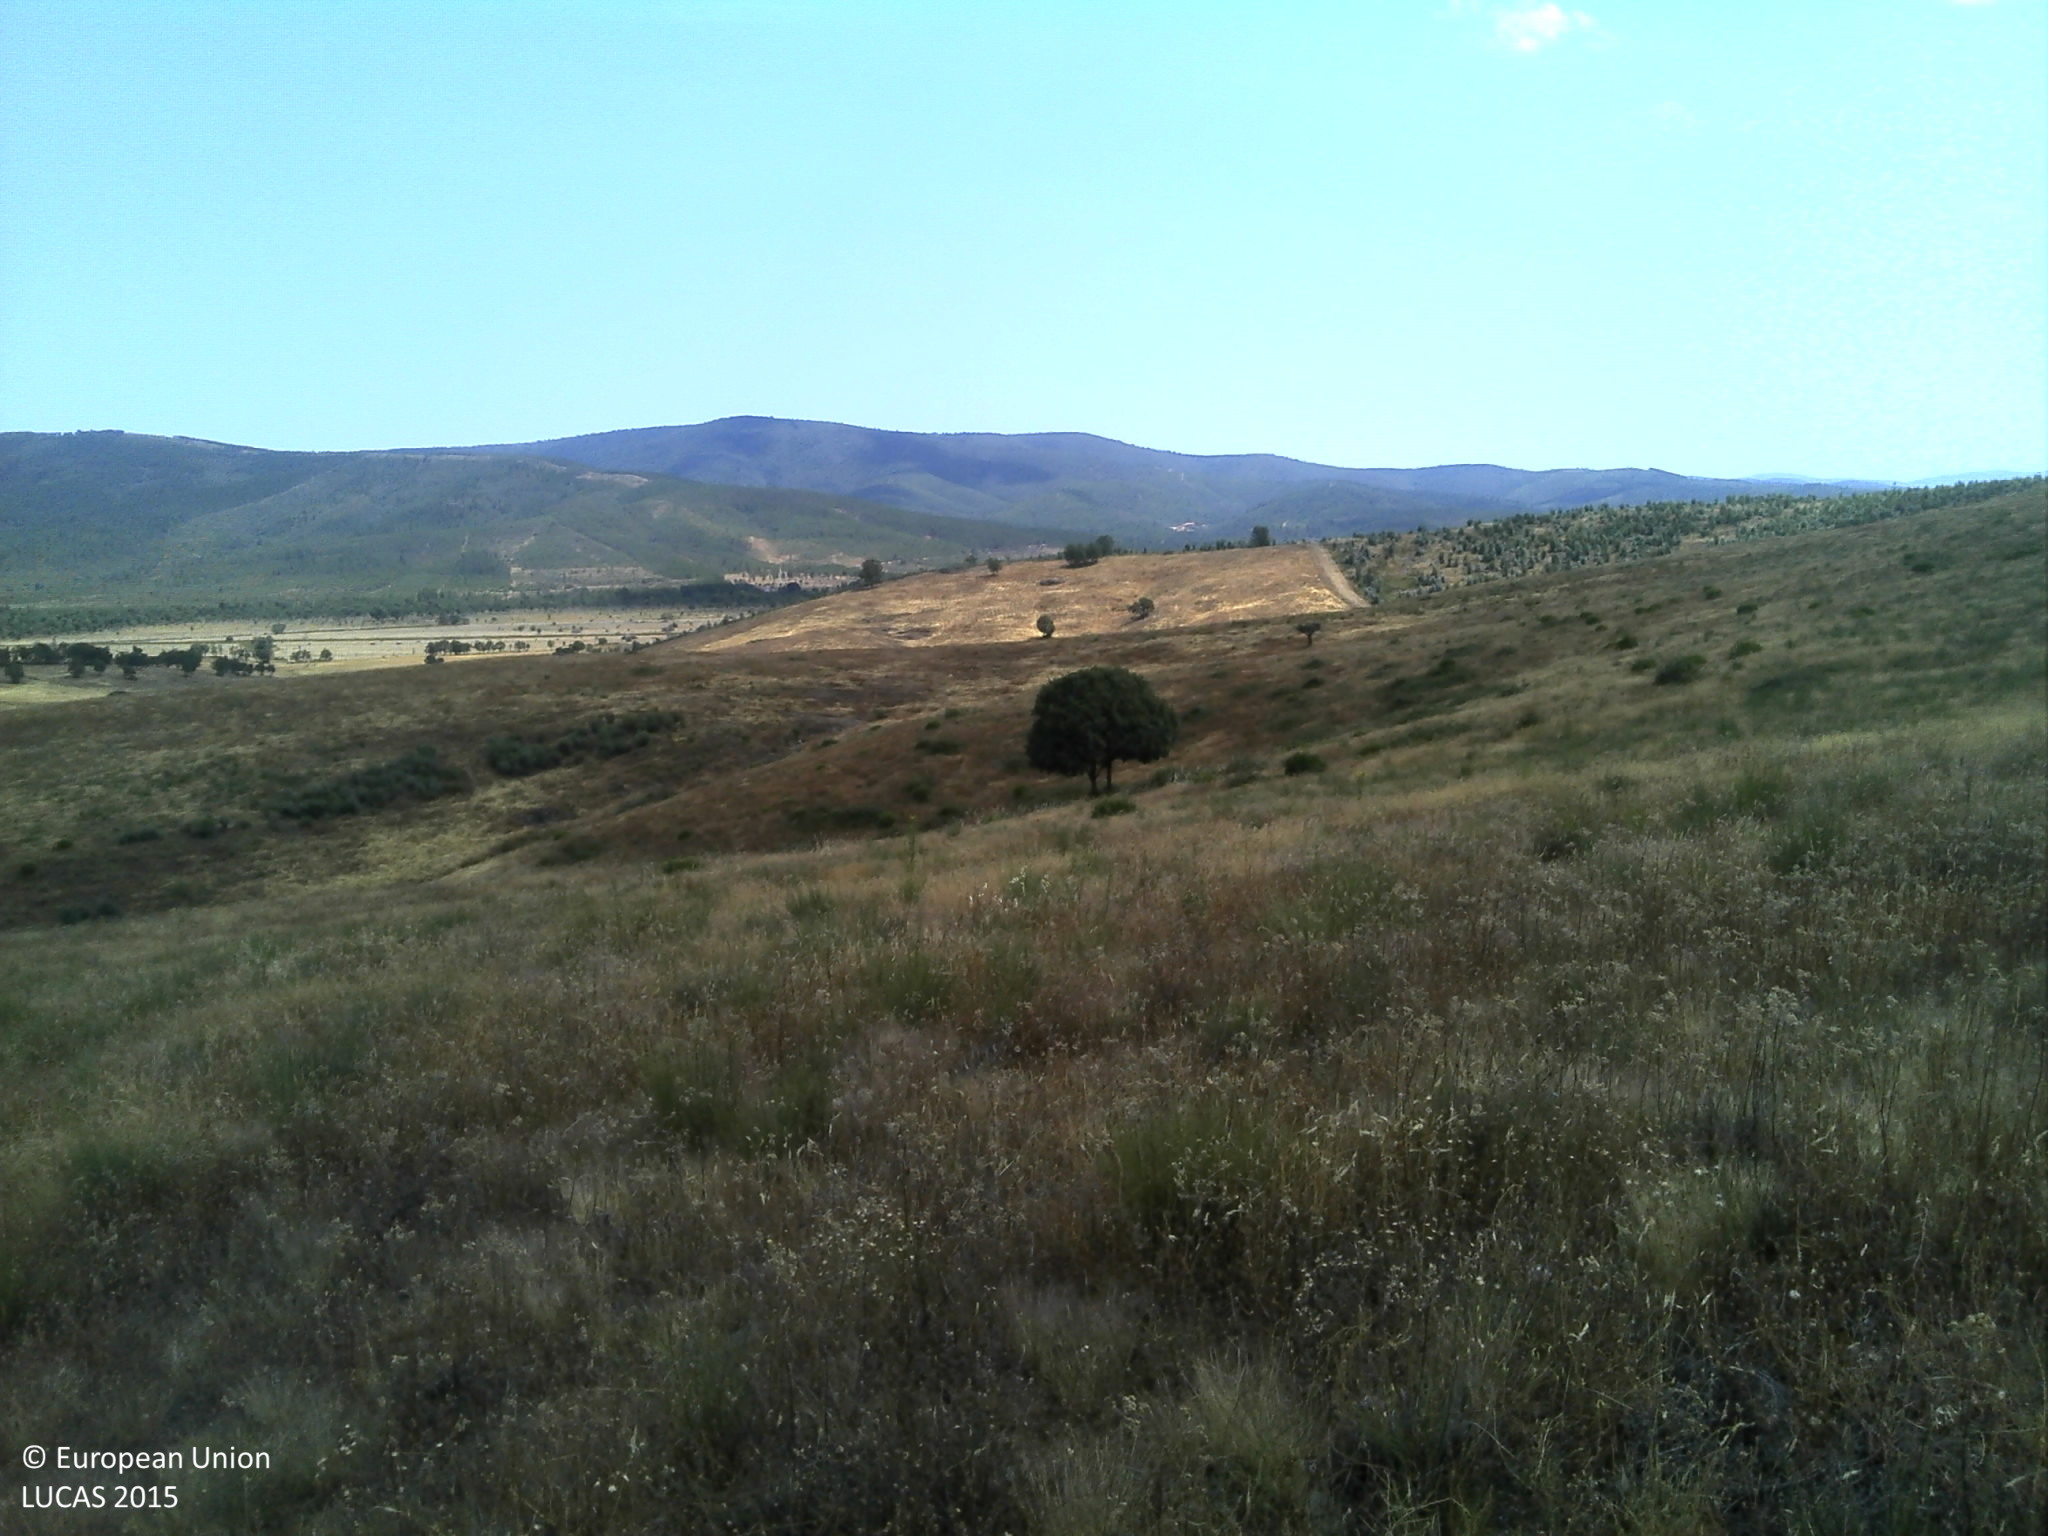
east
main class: Grassland
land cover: Grassland with sparse tree/shrub cover
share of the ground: 50 - 75 %
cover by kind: herbaceous plants 65 %, unconsolidated bare surface 25 %, broadleaved forest trees 5 %
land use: Agriculture (excluding fallow land and kitchen gardens)
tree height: > 5 m
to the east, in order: Grassland with sparse tree/shrub cover
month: June
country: PT
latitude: 40.1850
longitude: -7.1389
